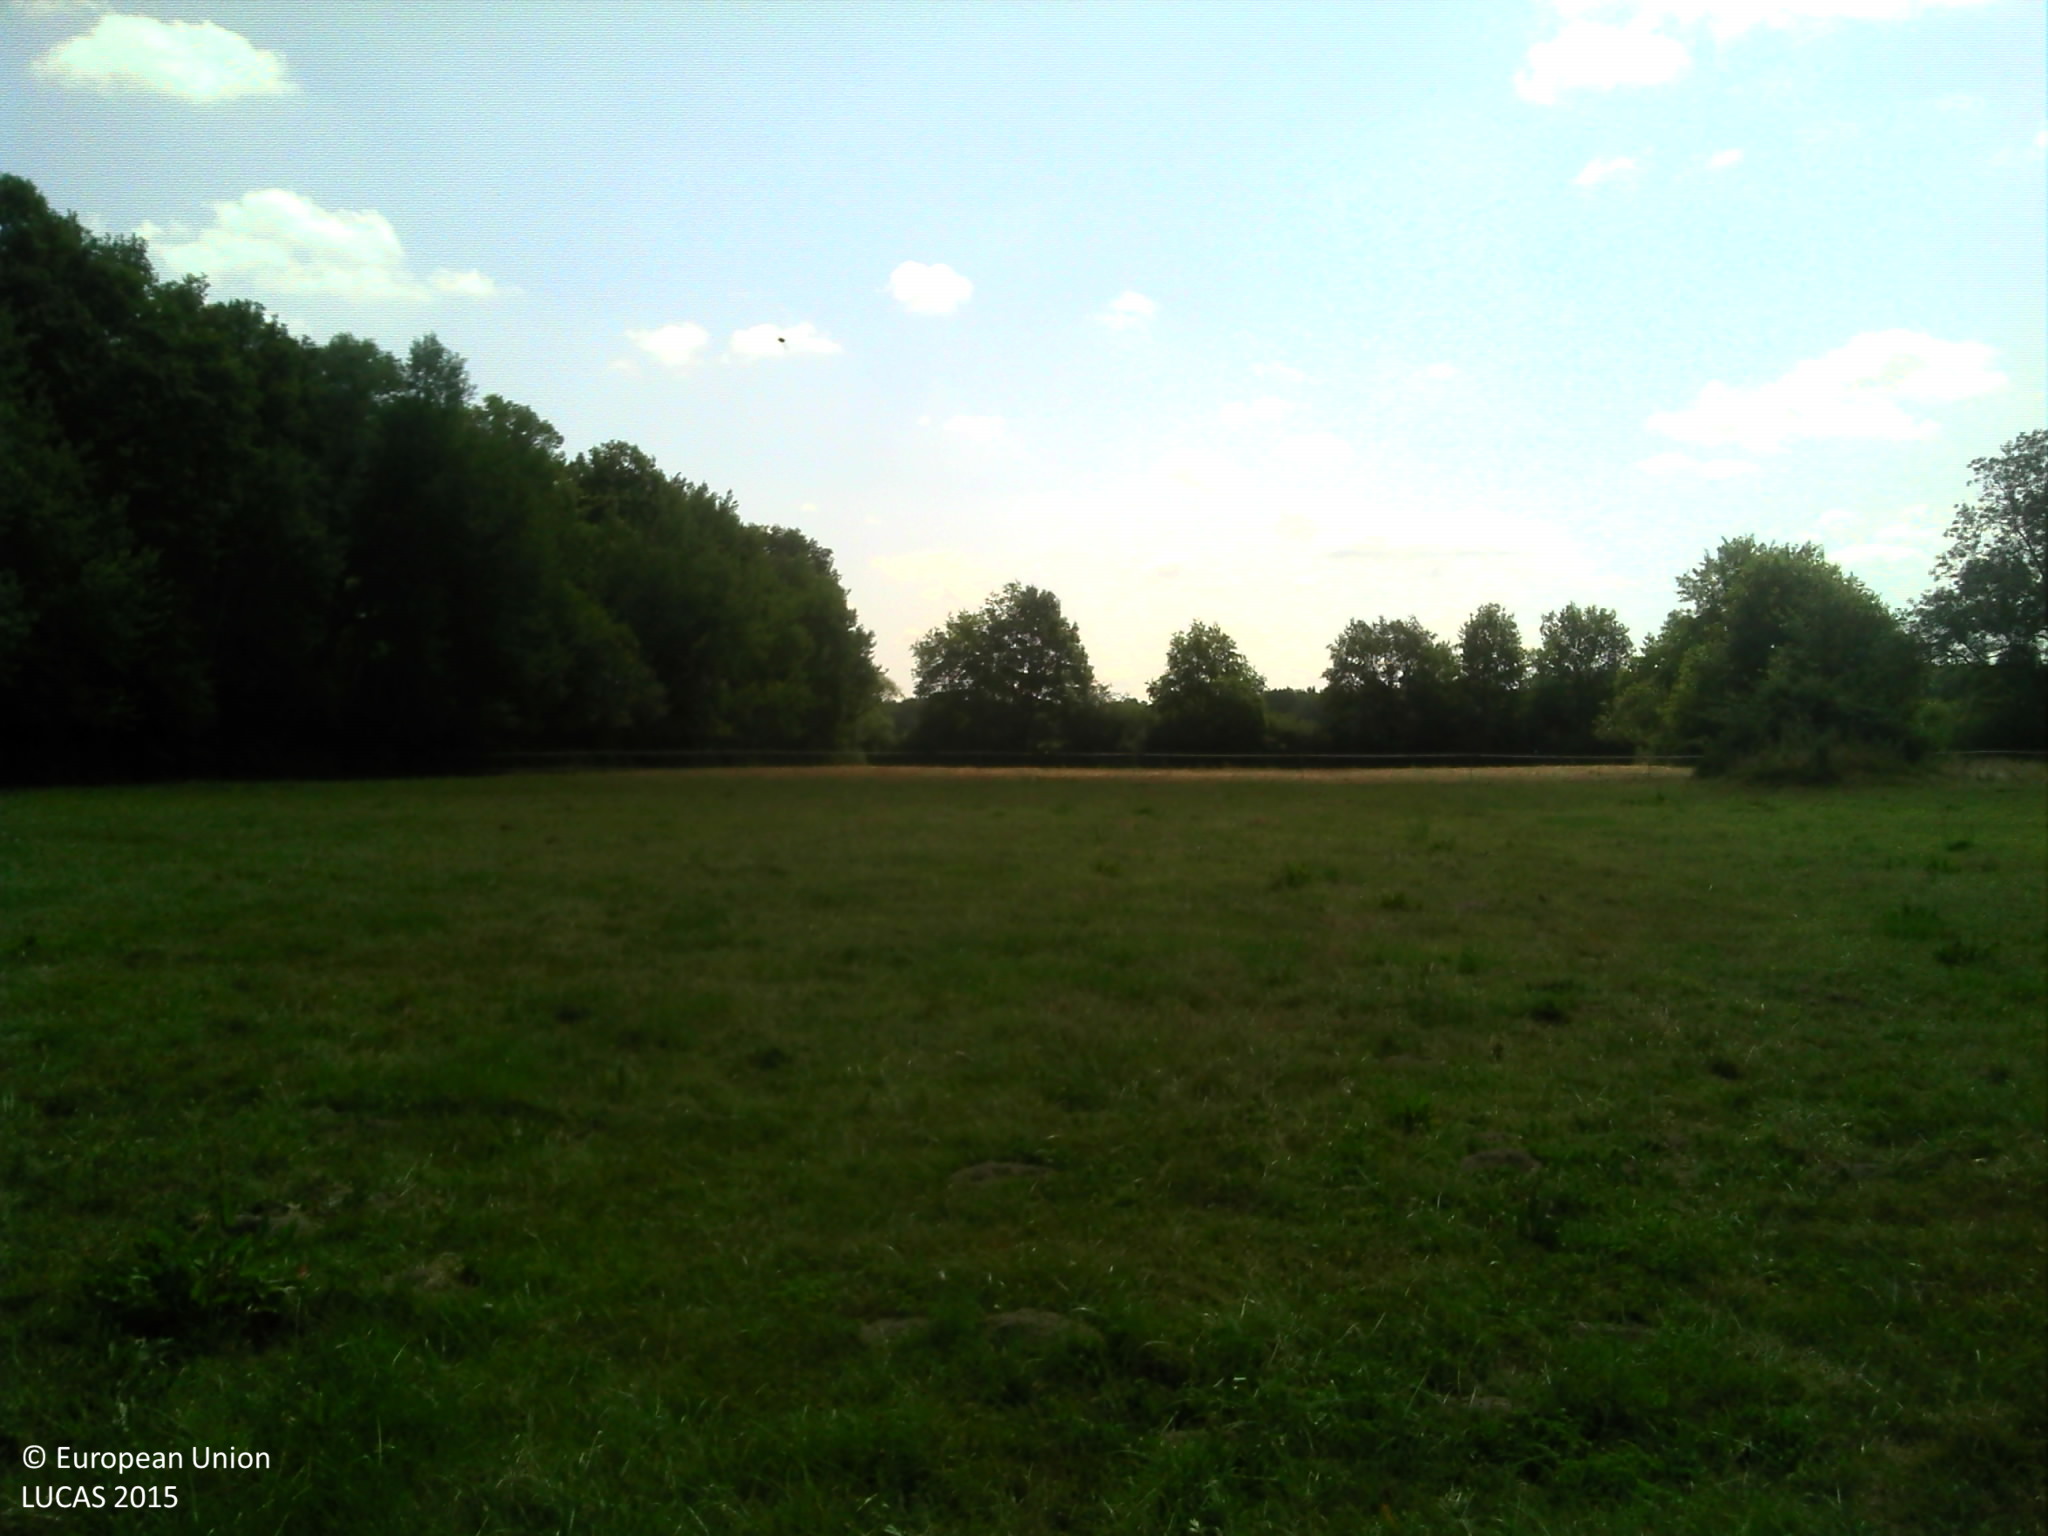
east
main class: Grassland
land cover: Grassland without tree/shrub cover
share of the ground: > 75 %
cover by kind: herbaceous plants 100 %
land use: Agriculture (excluding fallow land and kitchen gardens)
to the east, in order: Grassland without tree/shrub cover; Fences; Grassland without tree/shrub cover; Fences; Broadleaved woodland; Common wheat
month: July
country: FR
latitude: 46.8887
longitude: 5.1062
